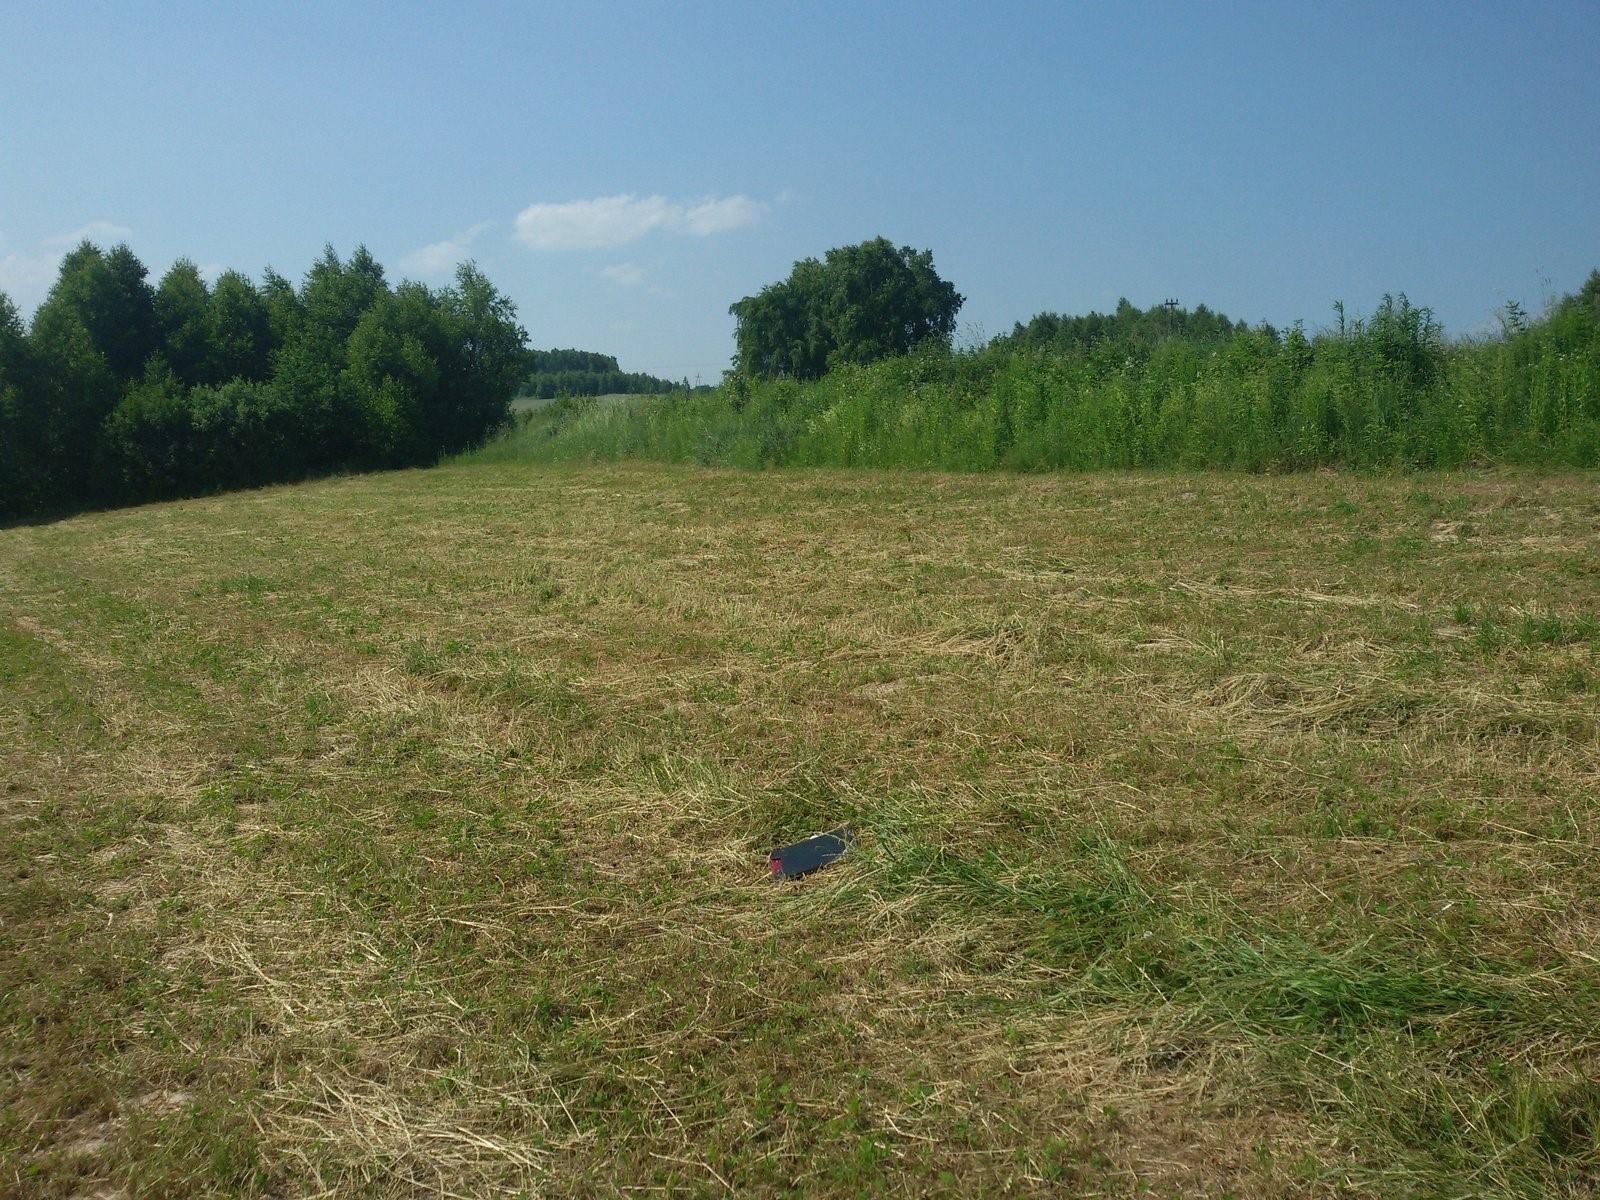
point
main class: Grassland
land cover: Grassland without tree/shrub cover
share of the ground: > 75 %
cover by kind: herbaceous plants 100 %
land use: Agriculture (excluding fallow land and kitchen gardens)
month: June
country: PL
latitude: 49.9994
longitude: 21.5039
